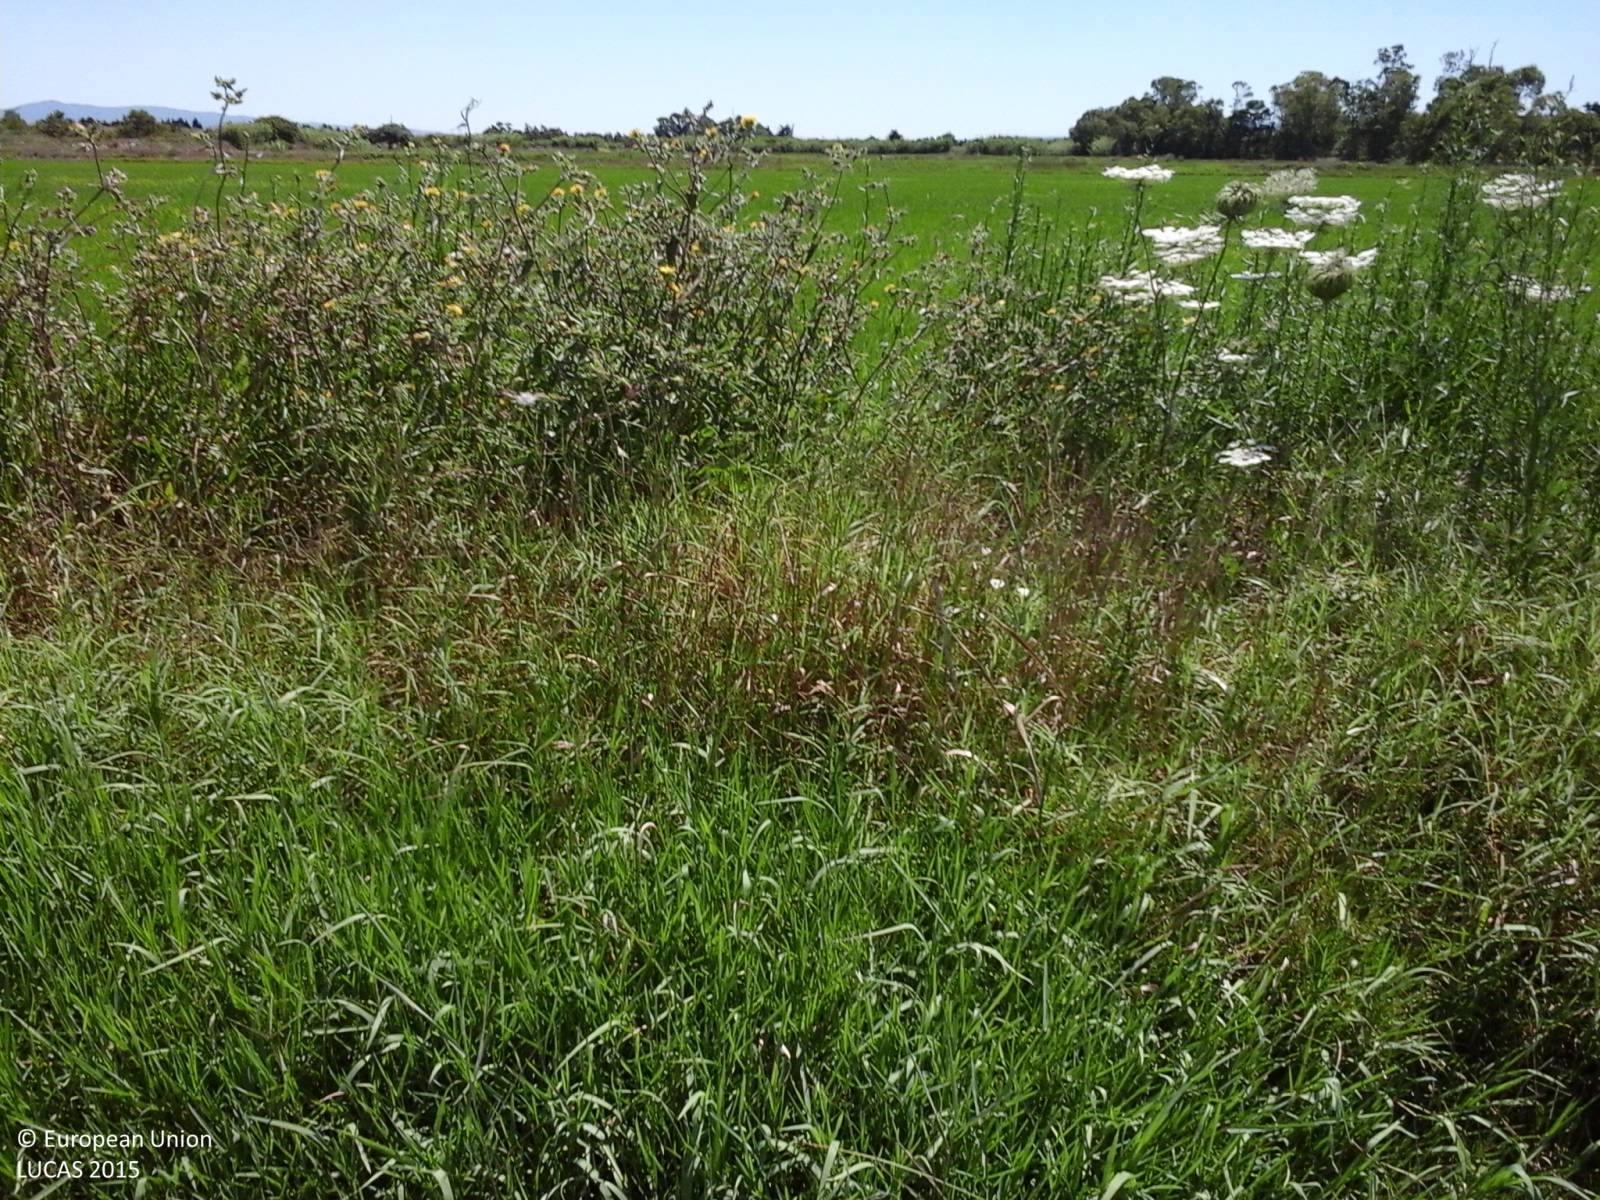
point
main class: Cropland
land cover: Rice
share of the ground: > 75 %
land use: Agriculture (excluding fallow land and kitchen gardens)
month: July
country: IT
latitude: 39.9494
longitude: 8.5915
